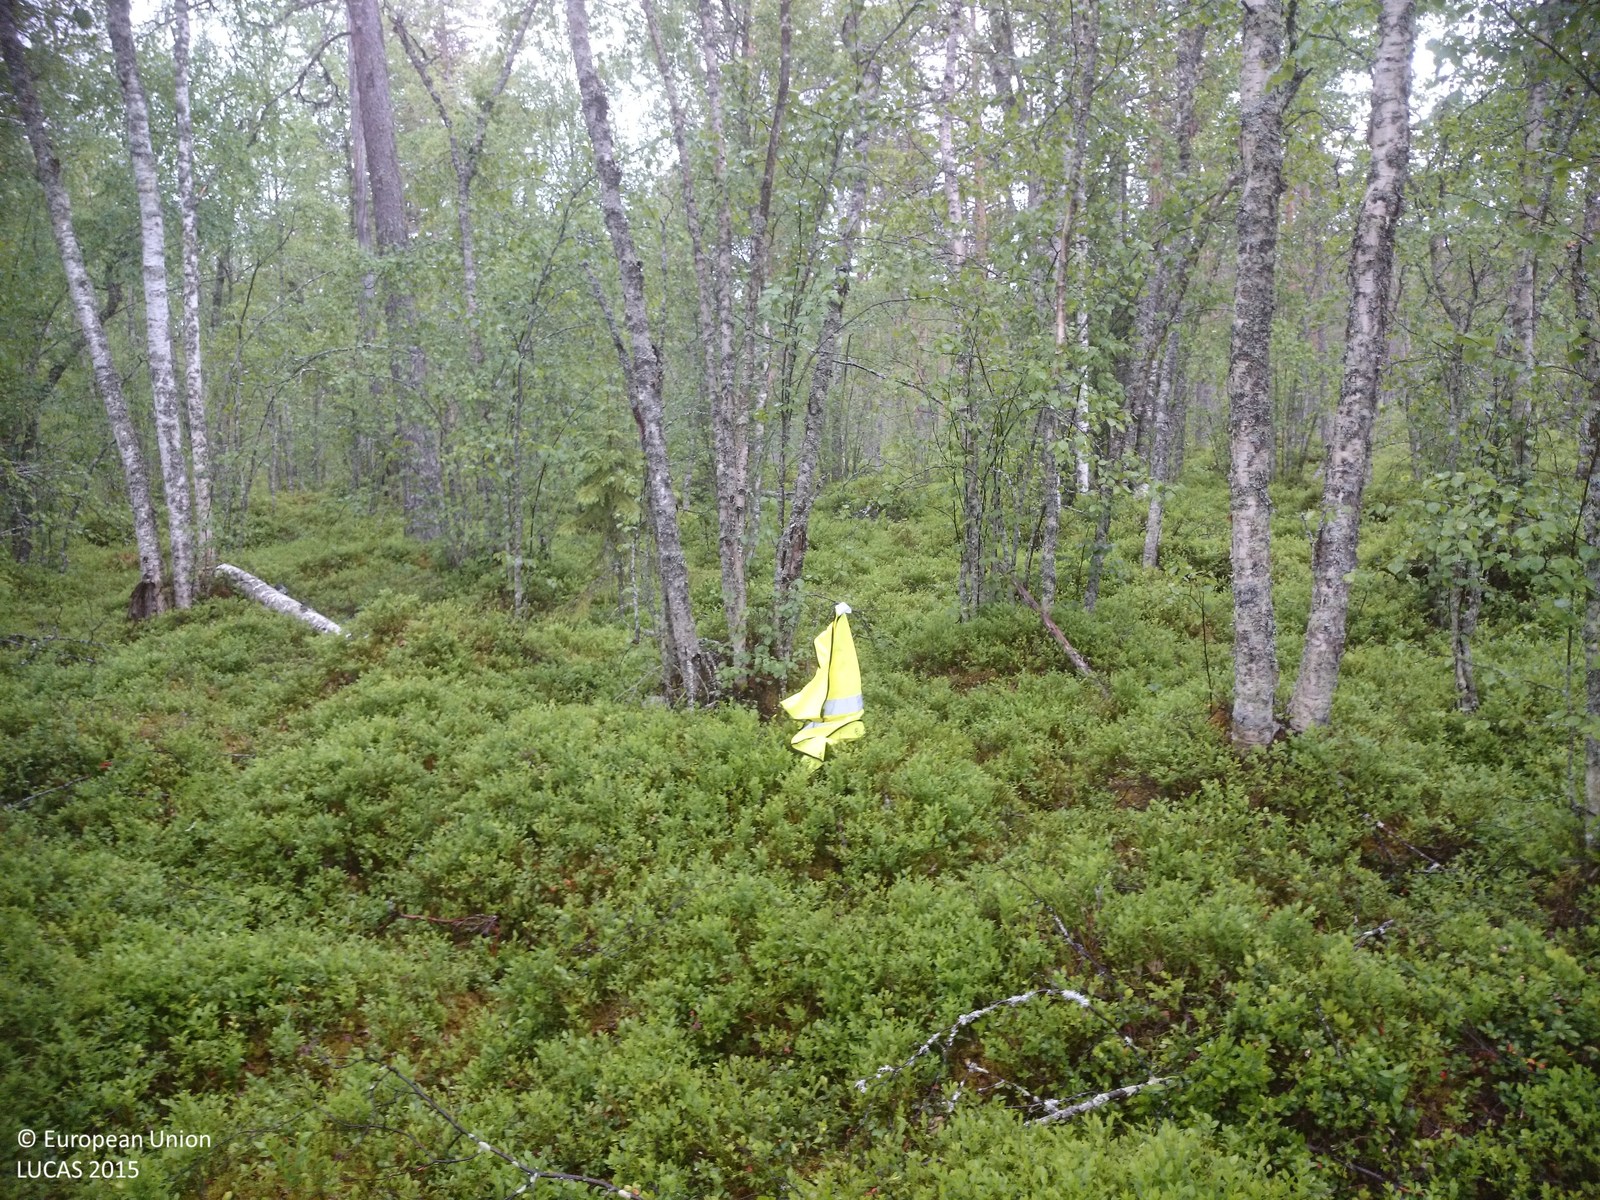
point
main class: Woodland
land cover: Broadleaved woodland
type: hemiboreal forest and nemoral coniferous forest and mixed broadleaved-coniferous forest
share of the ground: 25 - 50 %
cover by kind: shrubs 60 %, broadleaved forest trees 30 %, lichens and mosses 10 %
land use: Semi-natural and natural areas not in use
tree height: > 5 m
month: June
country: SE
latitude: 62.1029
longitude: 16.2459
